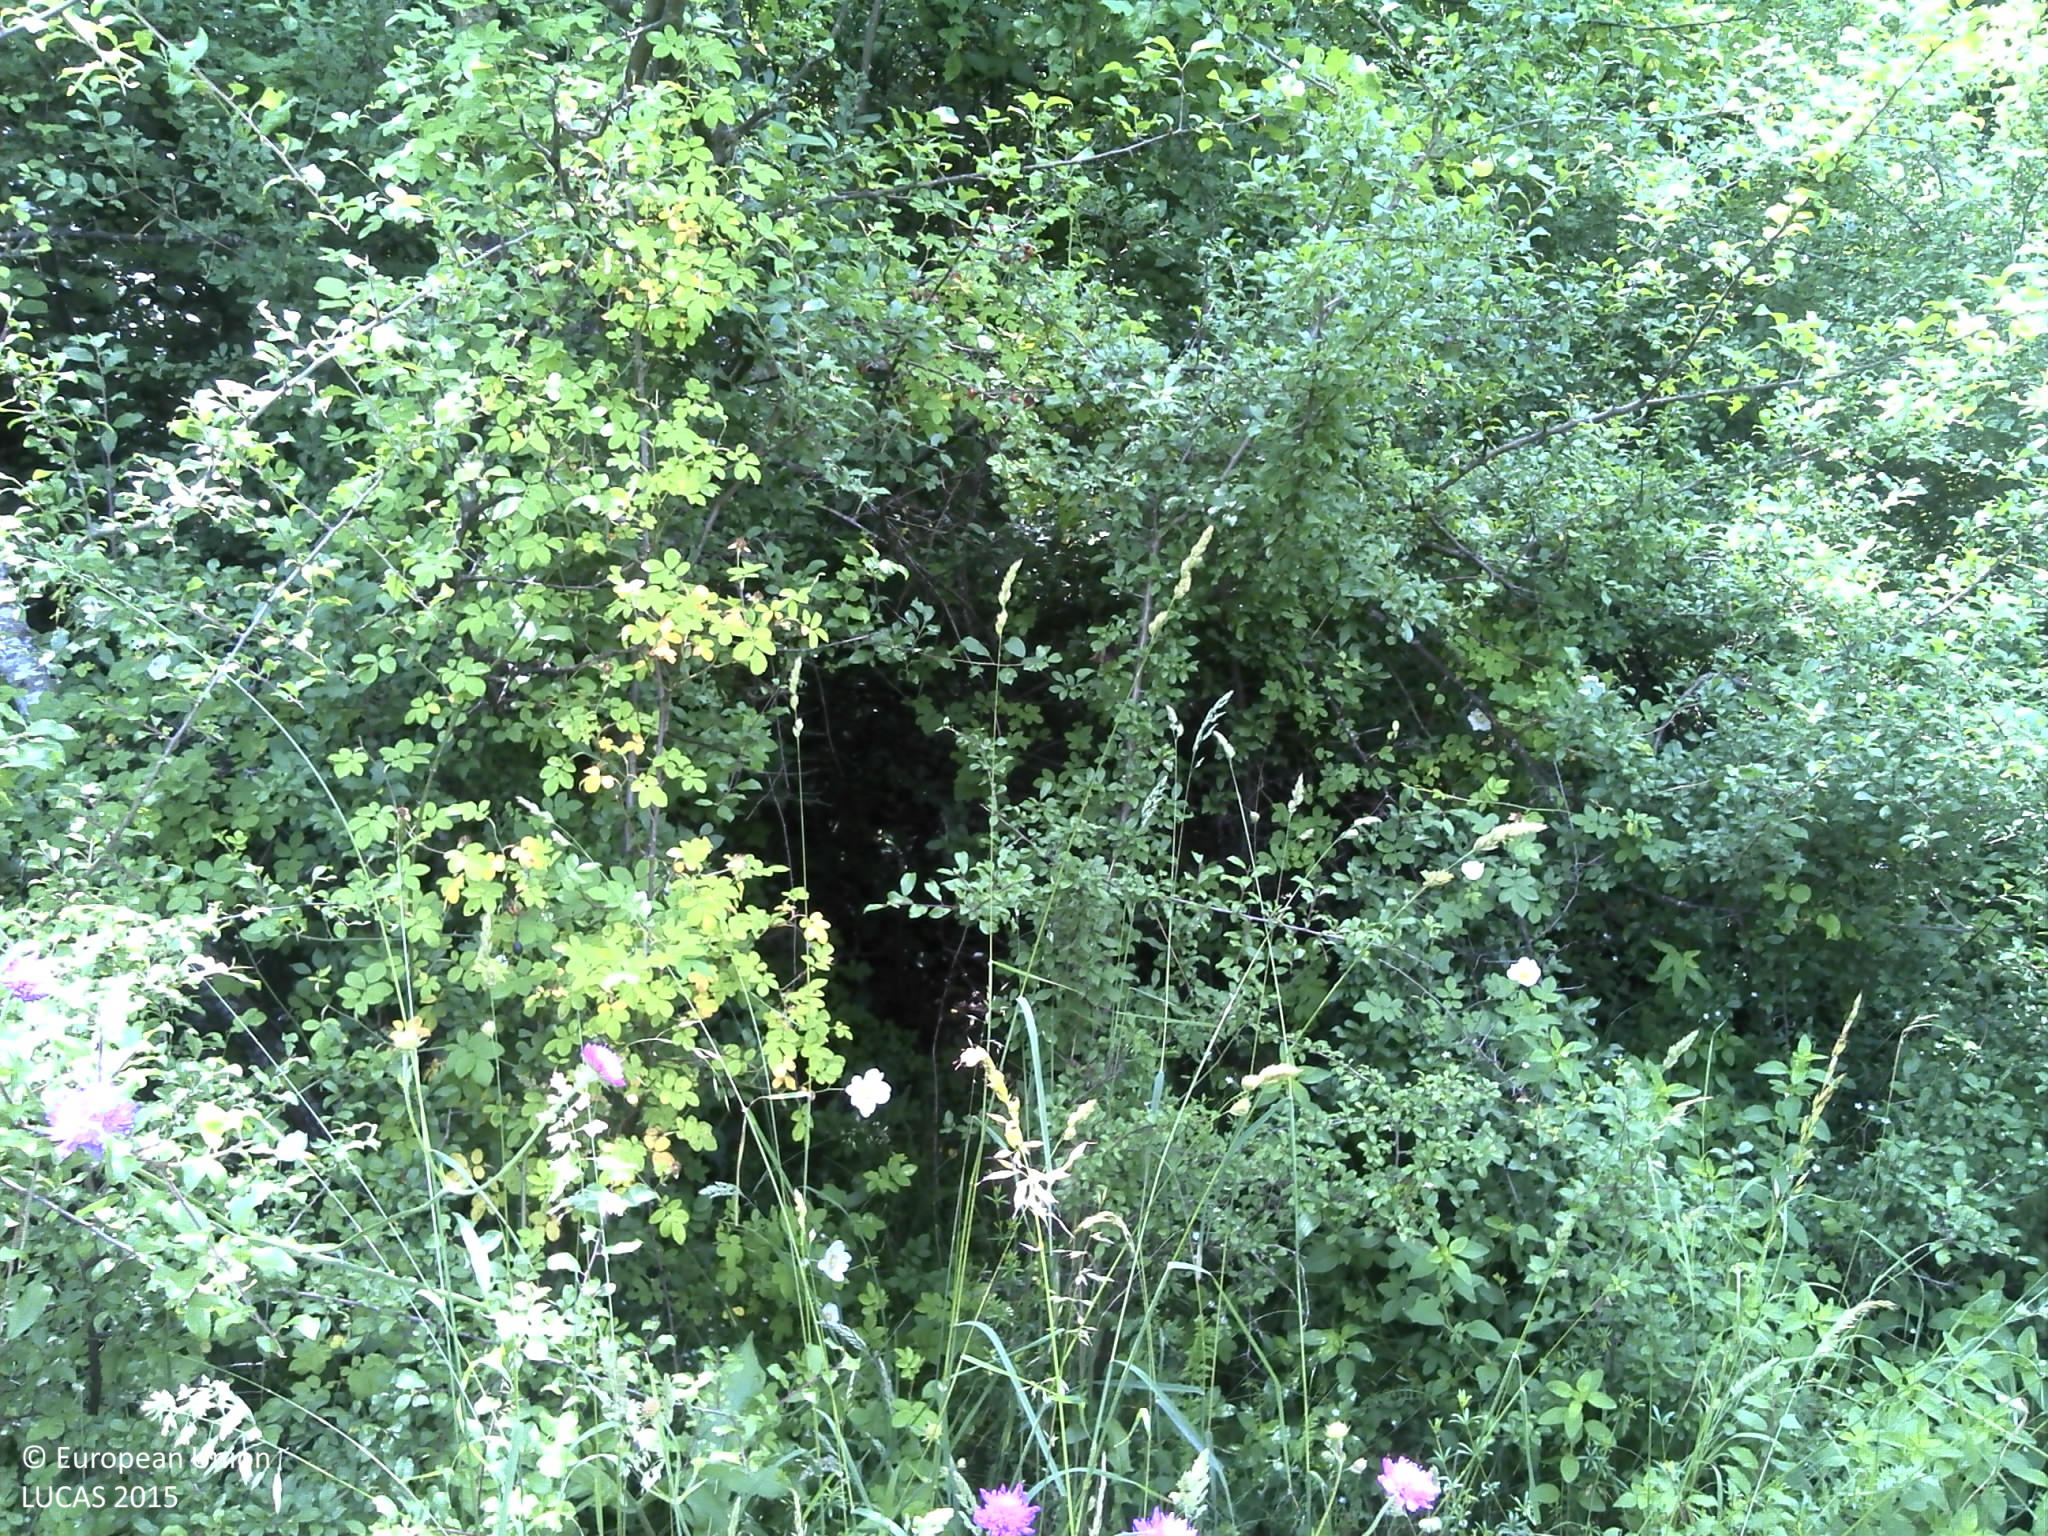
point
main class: Woodland
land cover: Broadleaved woodland
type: beech forest
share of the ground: > 75 %
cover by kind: broadleaved forest trees 95 %, herbaceous plants 5 %
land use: Semi-natural and natural areas not in use
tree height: > 5 m
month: June
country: HR
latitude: 44.5358
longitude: 16.0473
